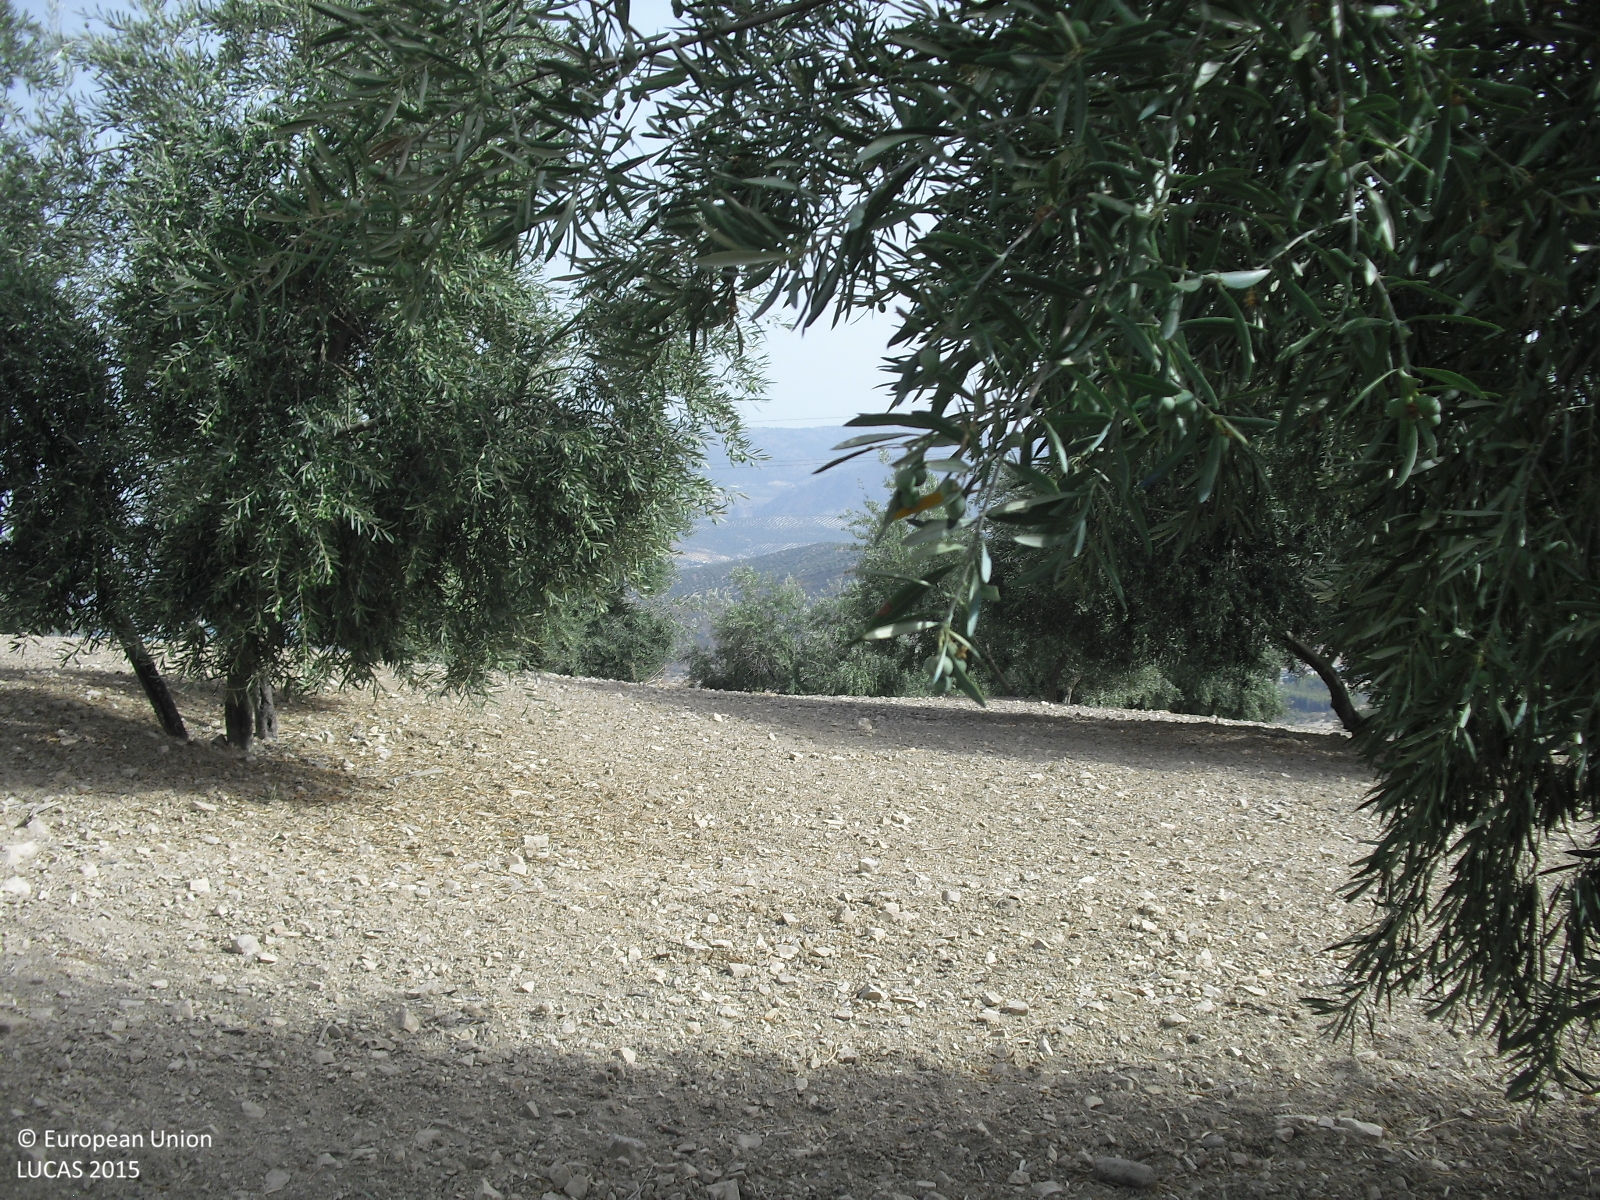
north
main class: Cropland
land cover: Olive groves
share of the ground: 25 - 50 %
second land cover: Other bare soil
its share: > 75 %
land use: Agriculture (excluding fallow land and kitchen gardens)
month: August
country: ES
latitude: 37.2450
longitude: -4.3263
